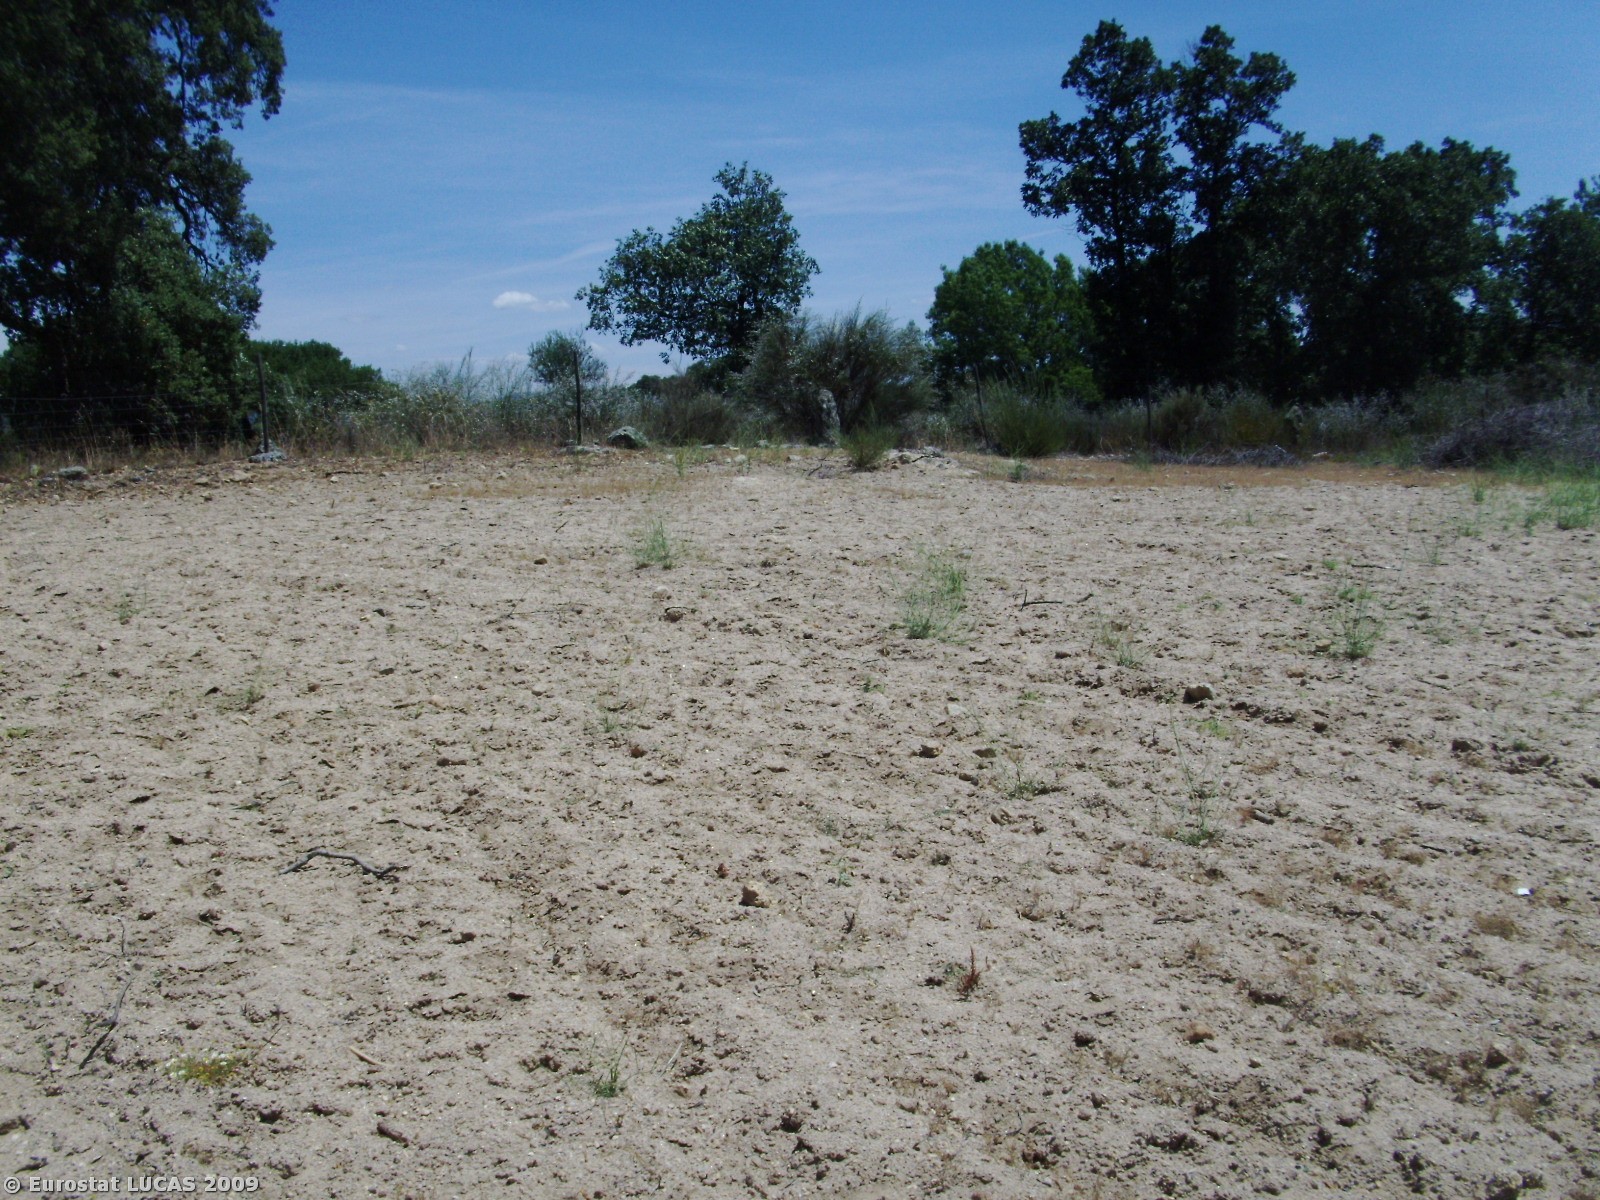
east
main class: Cropland
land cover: Olive groves
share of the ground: 10 - 25 %
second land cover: Bare land
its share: > 75 %
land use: Agriculture (excluding fallow land and kitchen gardens)
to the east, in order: Olive groves; Fences; Broadleaved woodland; Dry stone walls; Rivers and streams; Dry stone walls; Spontaneously vegetated surfaces; Olive groves; Broadleaved woodland
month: June
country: PT
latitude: 40.1418
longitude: -7.1751
